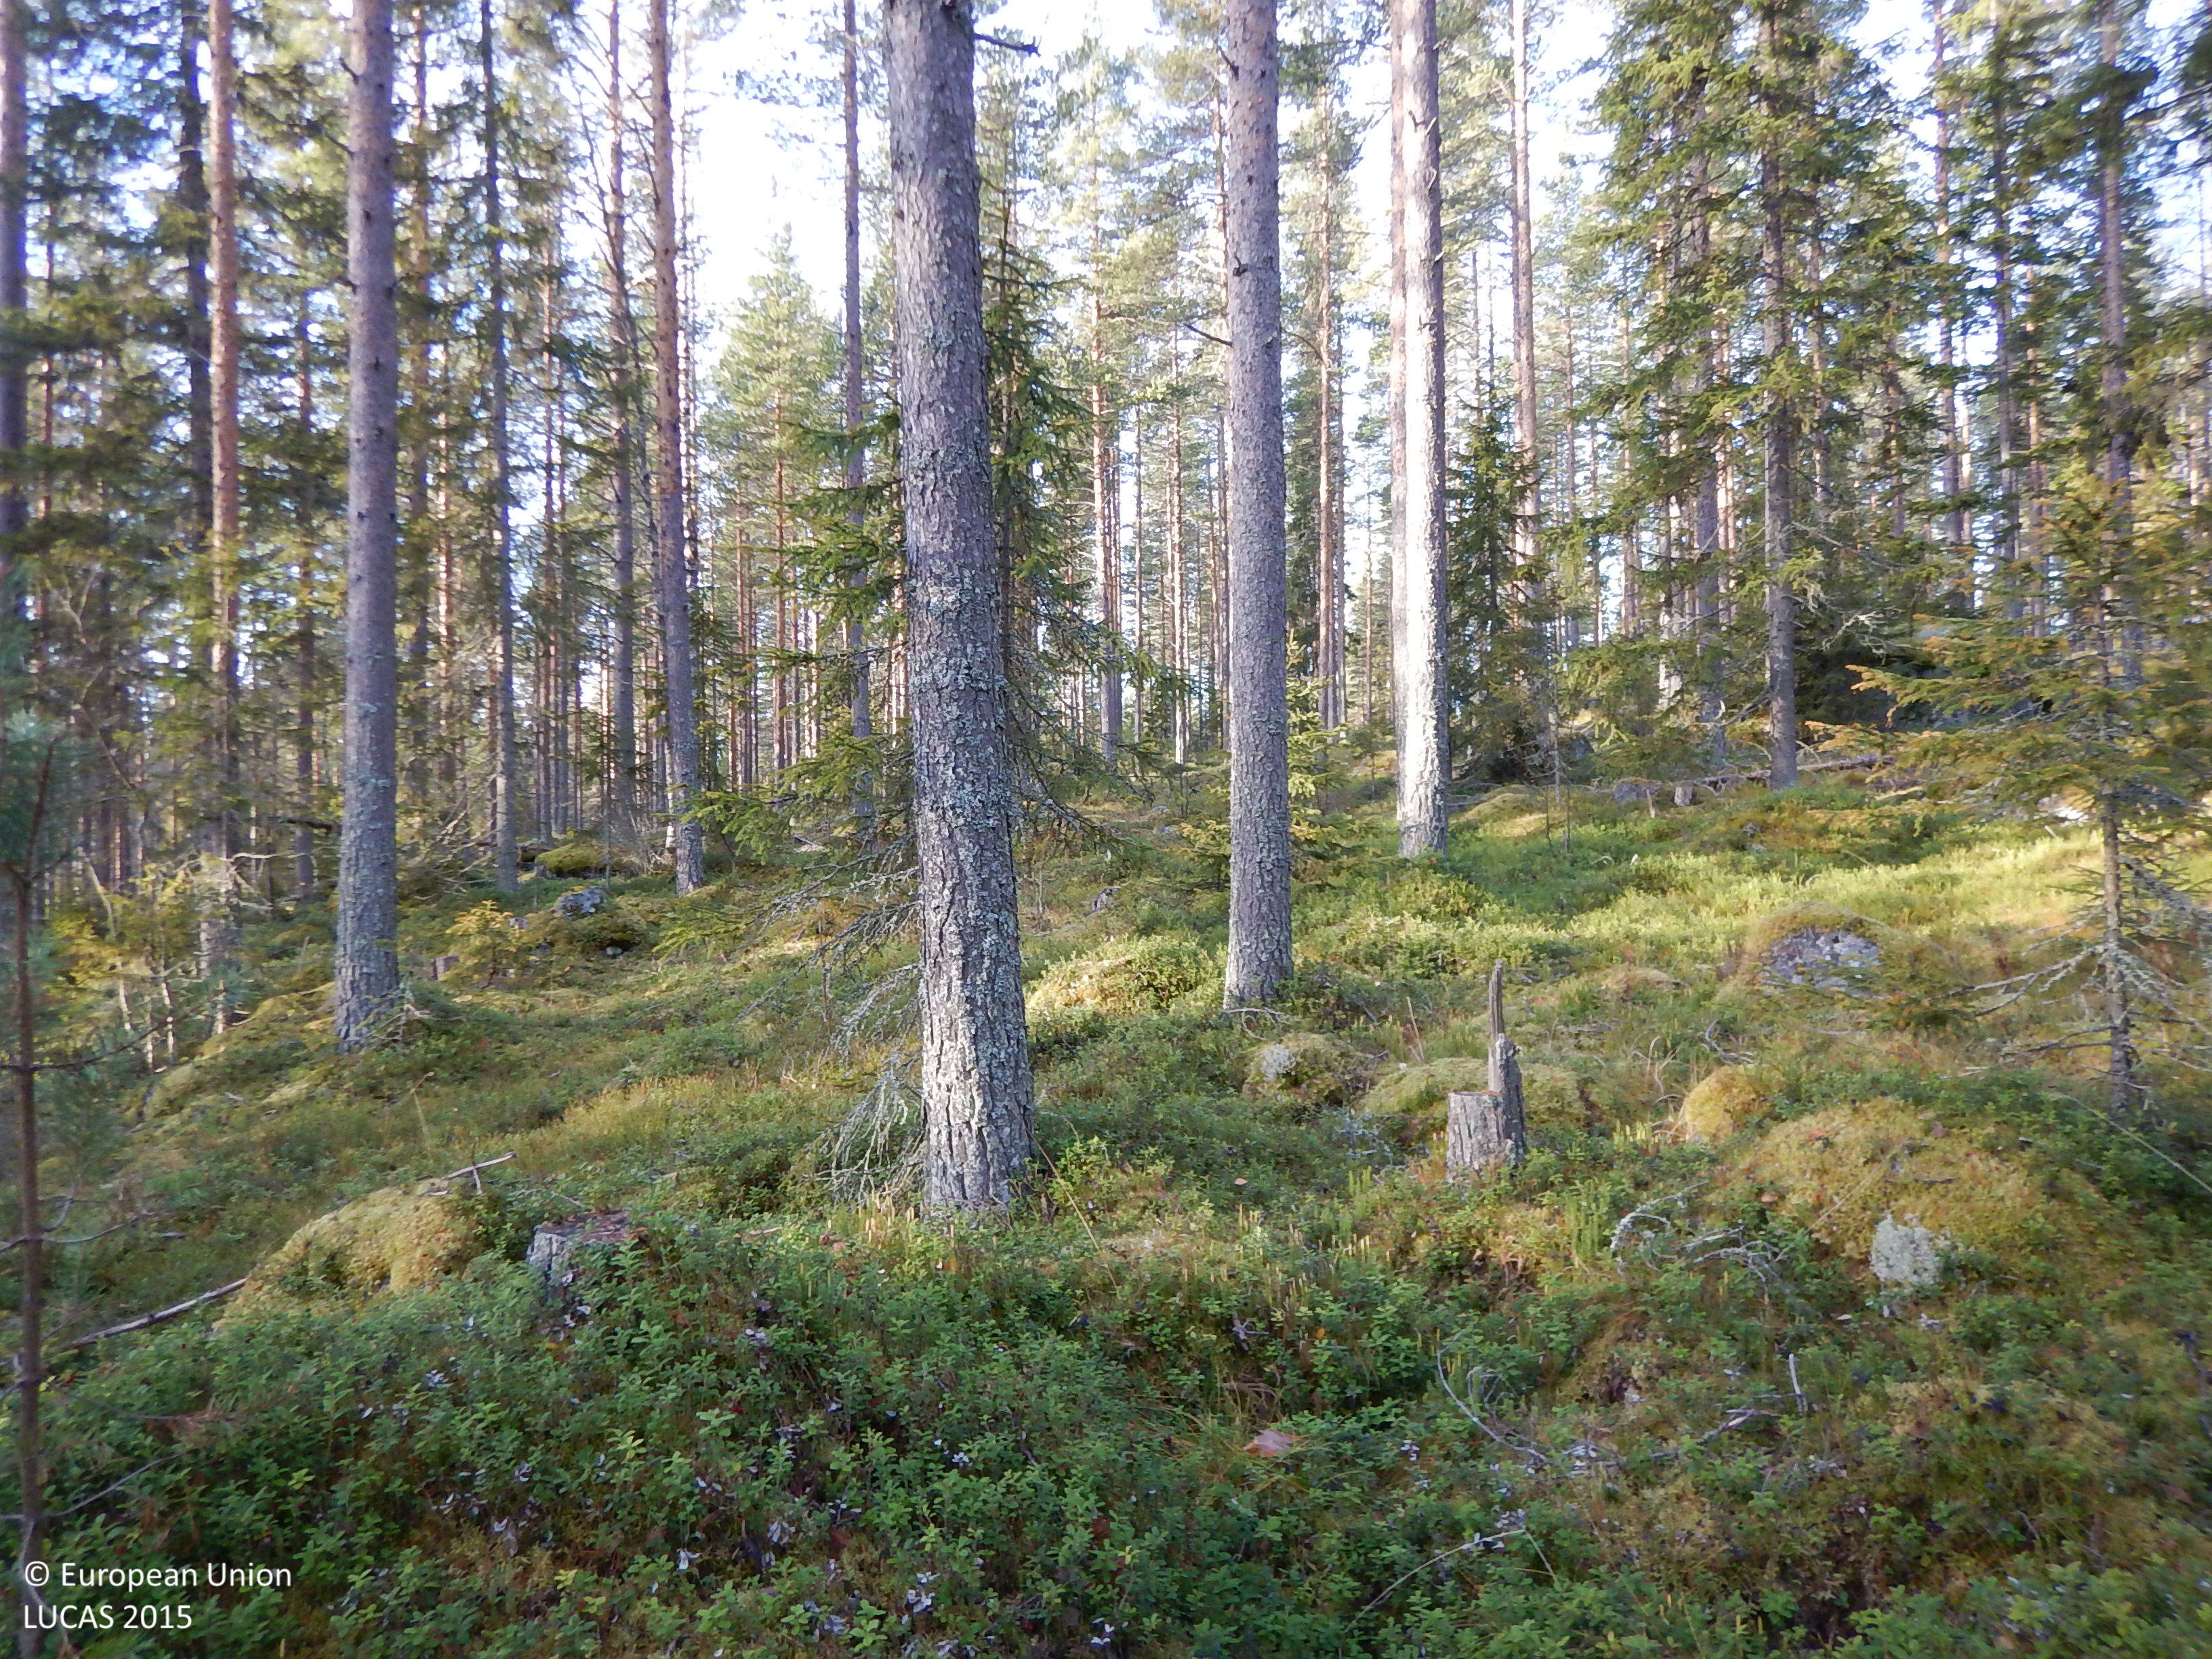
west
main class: Woodland
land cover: Other coniferous woodland
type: boreal forest
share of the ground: 50 - 75 %
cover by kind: coniferous forest trees 60 %, shrubs 15 %, lichens and mosses 15 %, broadleaved forest trees 5 %, herbaceous plants 5 %
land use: Forestry
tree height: > 5 m
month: November
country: SE
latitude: 65.1771
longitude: 20.8388
